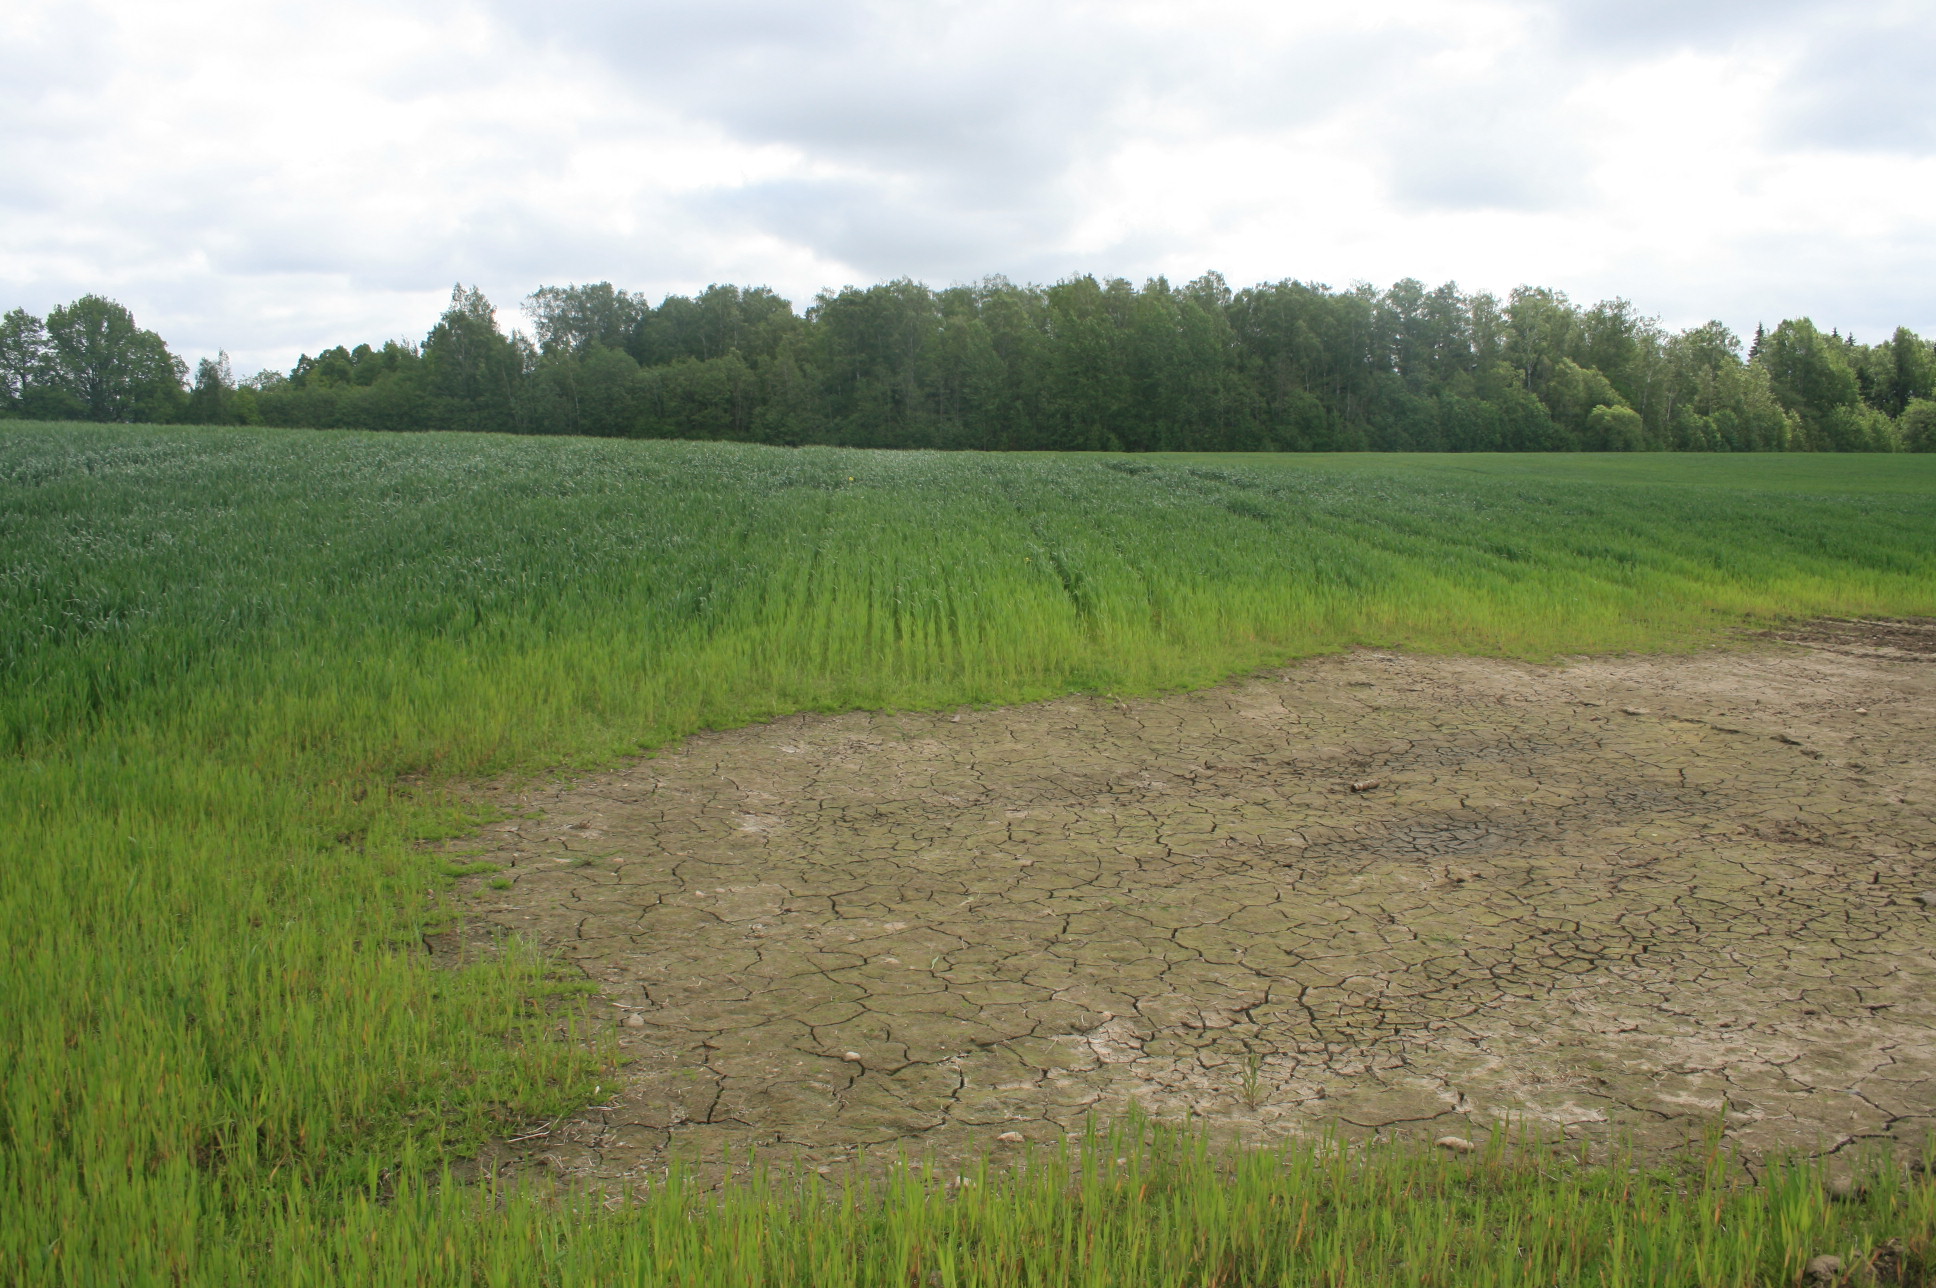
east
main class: Cropland
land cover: Rye
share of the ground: 50 - 75 %
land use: Agriculture (excluding fallow land and kitchen gardens)
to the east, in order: Rye; Other bare soil; Rye; Shruby margins; Broadleaved woodland
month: June
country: LT
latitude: 56.2600
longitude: 22.3736
